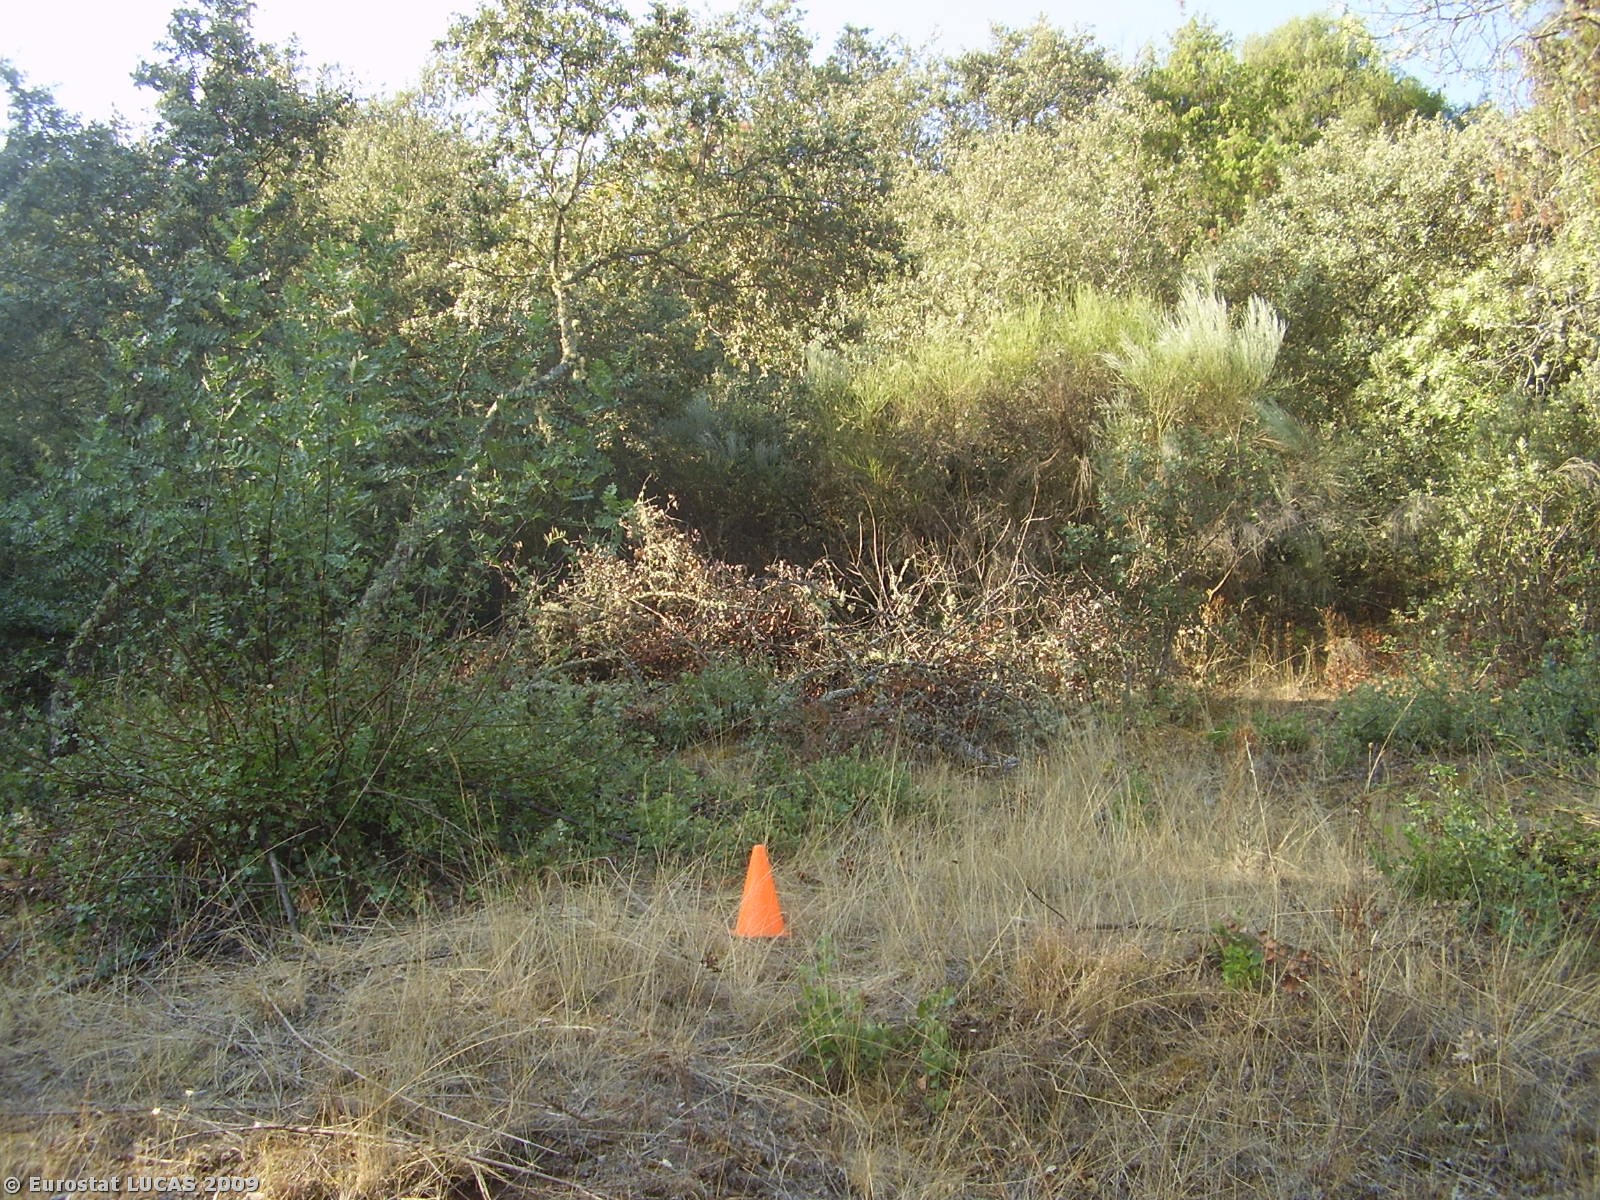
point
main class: Woodland
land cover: Broadleaved woodland
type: broadleaved evergreen forest
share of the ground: 10 - 25 %
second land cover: Spontaneously vegetated surfaces
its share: > 75 %
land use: Forestry
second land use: Fallow land
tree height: > 5 m
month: August
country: PT
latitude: 41.3879
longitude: -6.7904
